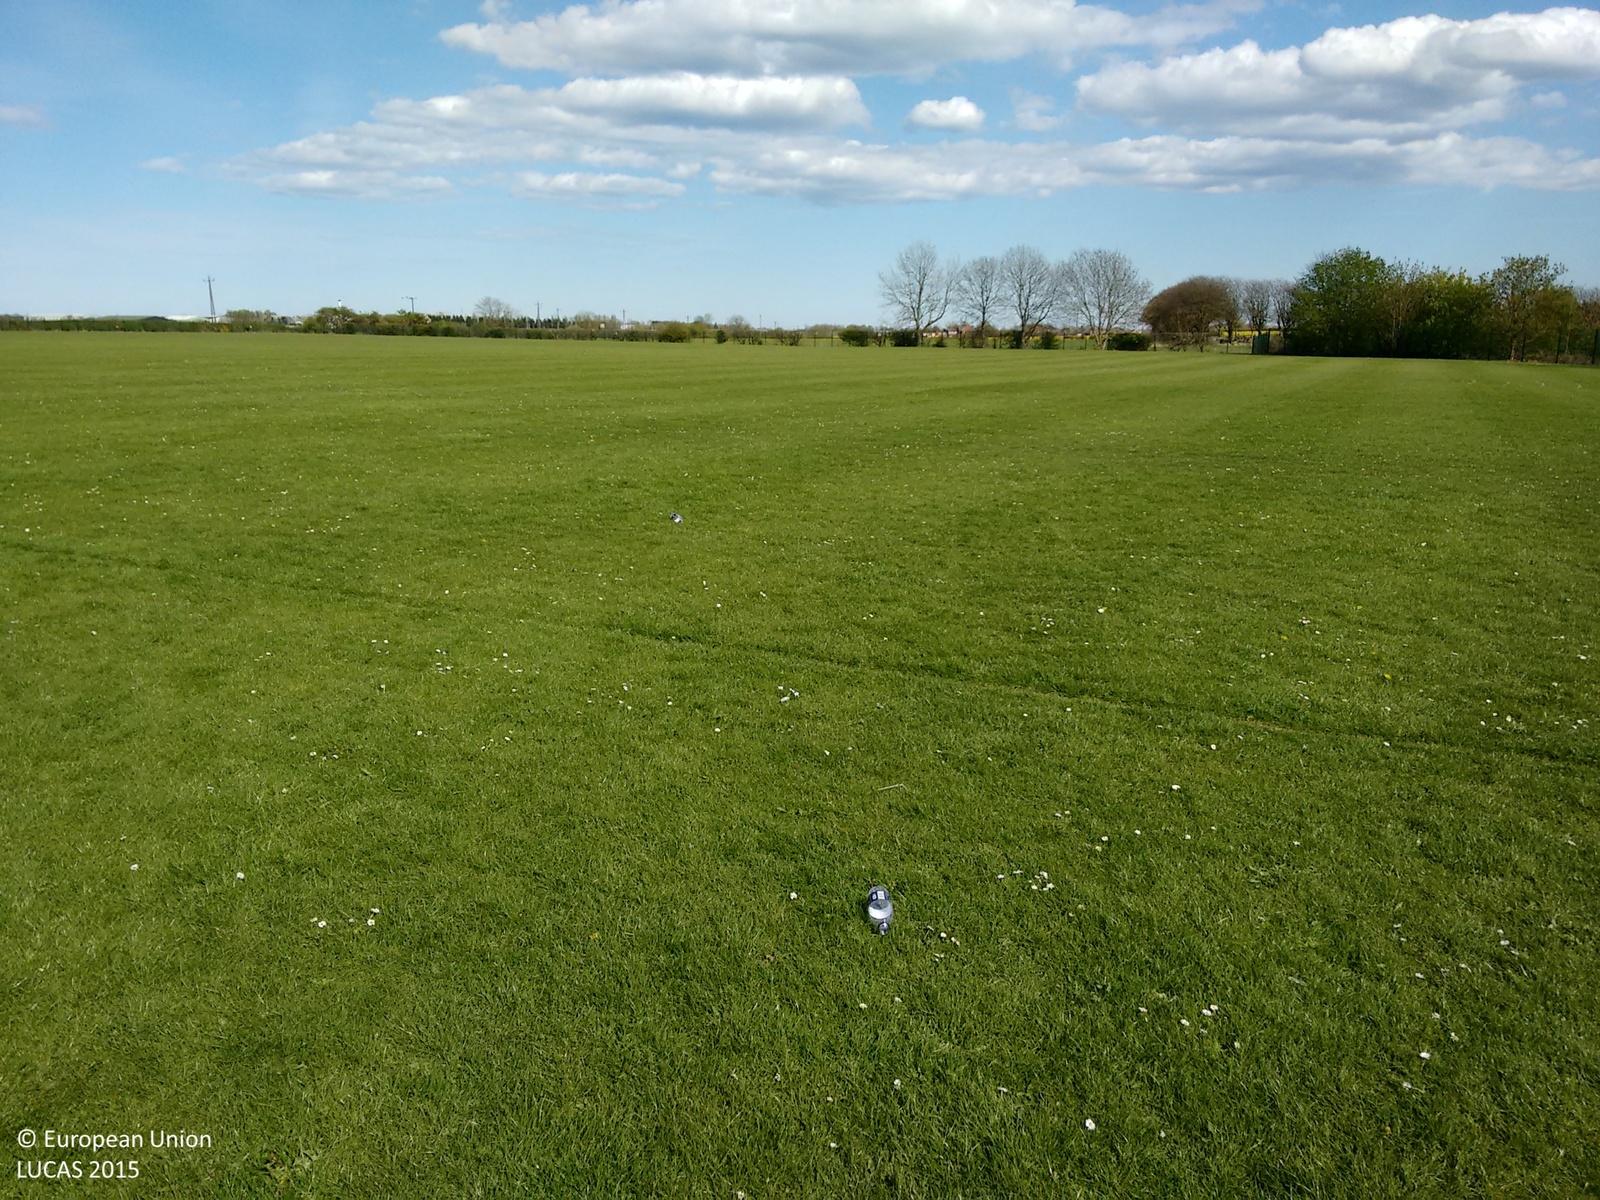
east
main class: Grassland
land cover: Grassland without tree/shrub cover
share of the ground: > 75 %
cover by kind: herbaceous plants 100 %
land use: Community services
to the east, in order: Grassland without tree/shrub cover; Managed hedges; Fences; Grassland without tree/shrub cover; Rape and turnip rape
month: April
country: GB
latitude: 55.0579
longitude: -1.6182
